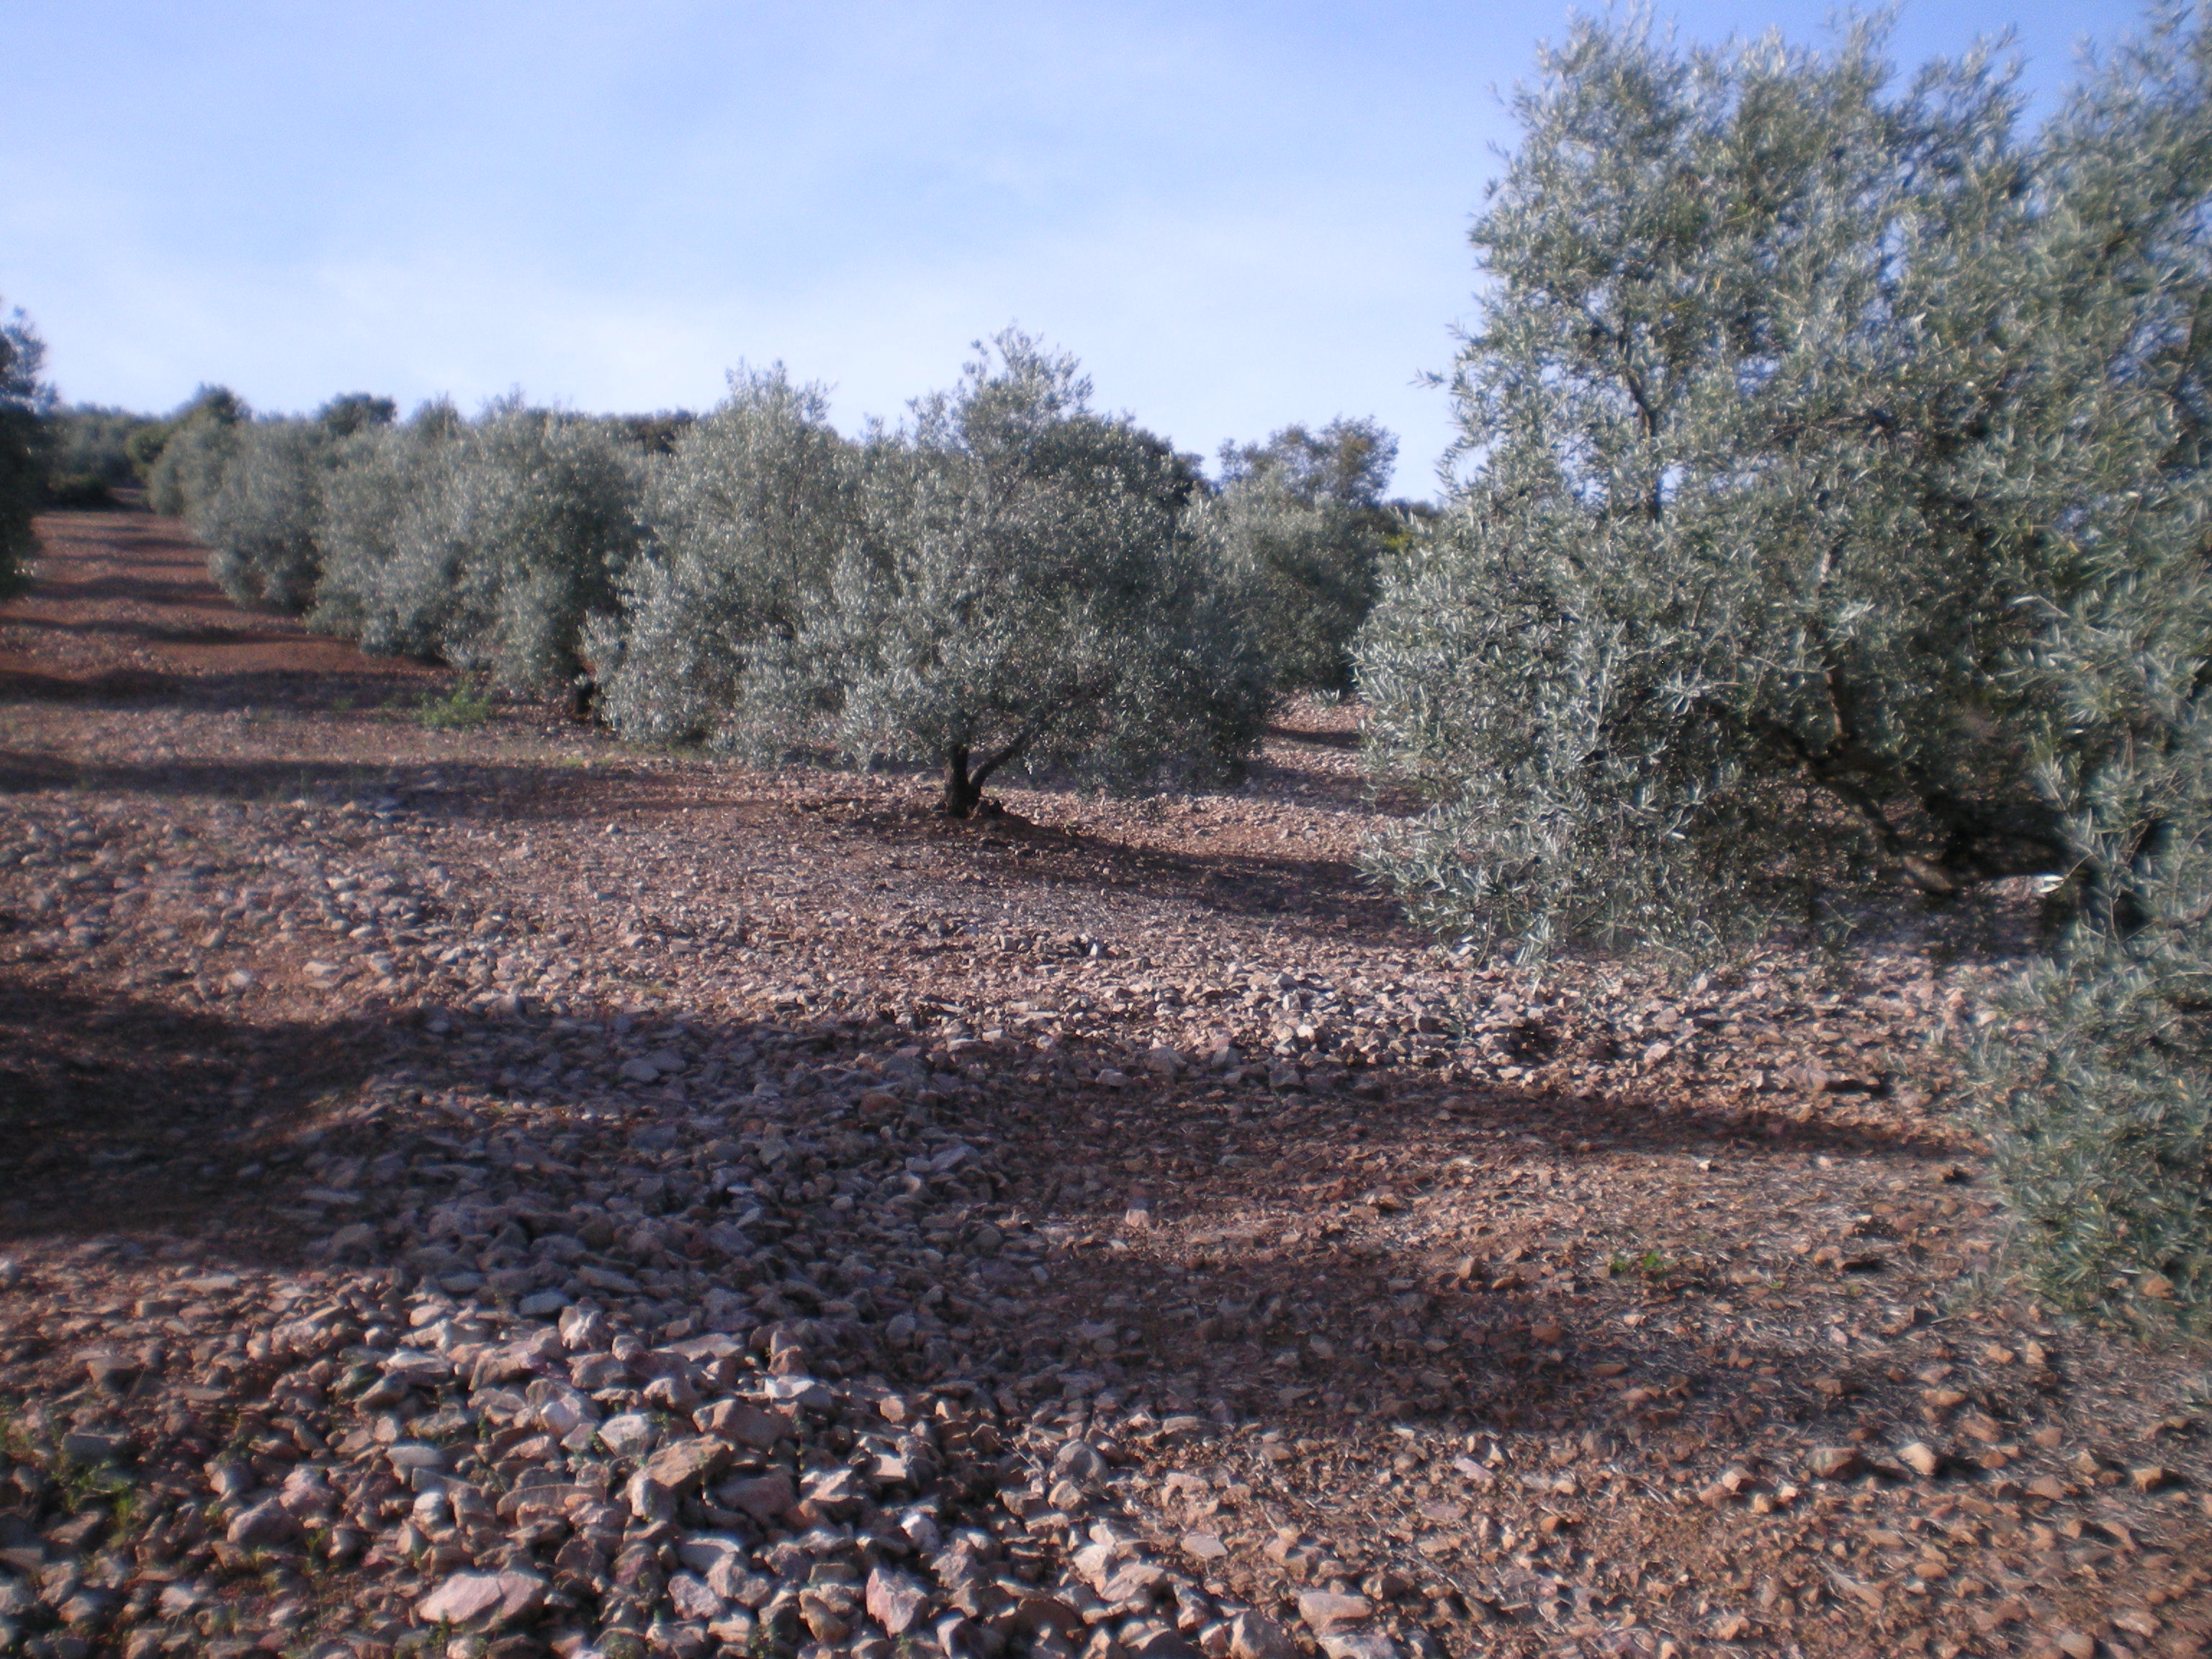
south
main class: Cropland
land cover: Olive groves
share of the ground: 25 - 50 %
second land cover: Other bare soil
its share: > 75 %
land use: Agriculture (excluding fallow land and kitchen gardens)
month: April
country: ES
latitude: 38.5374
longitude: -3.0021
